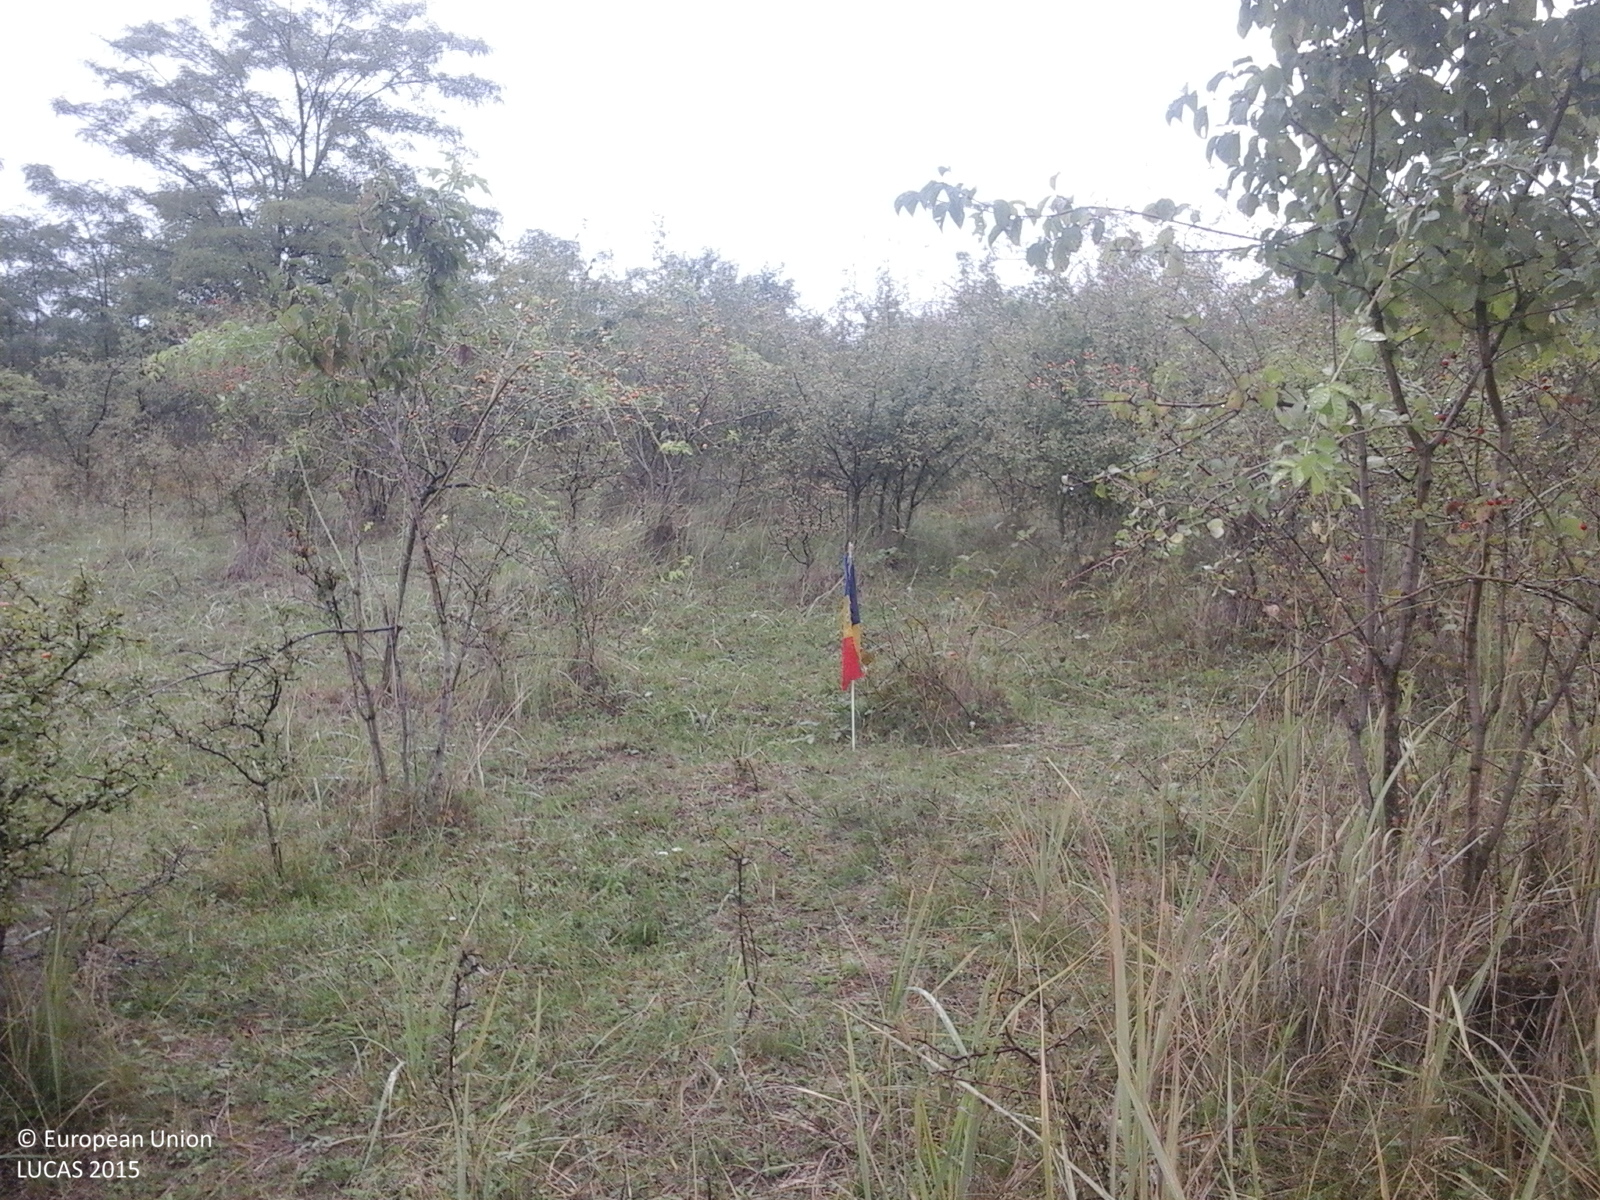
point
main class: Shrubland
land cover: Shrubland with sparse tree cover
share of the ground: > 75 %
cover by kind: shrubs 55 %, herbaceous plants 40 %, broadleaved forest trees 5 %
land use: Semi-natural and natural areas not in use
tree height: < 5 m
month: September
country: RO
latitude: 47.3820
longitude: 22.4939
